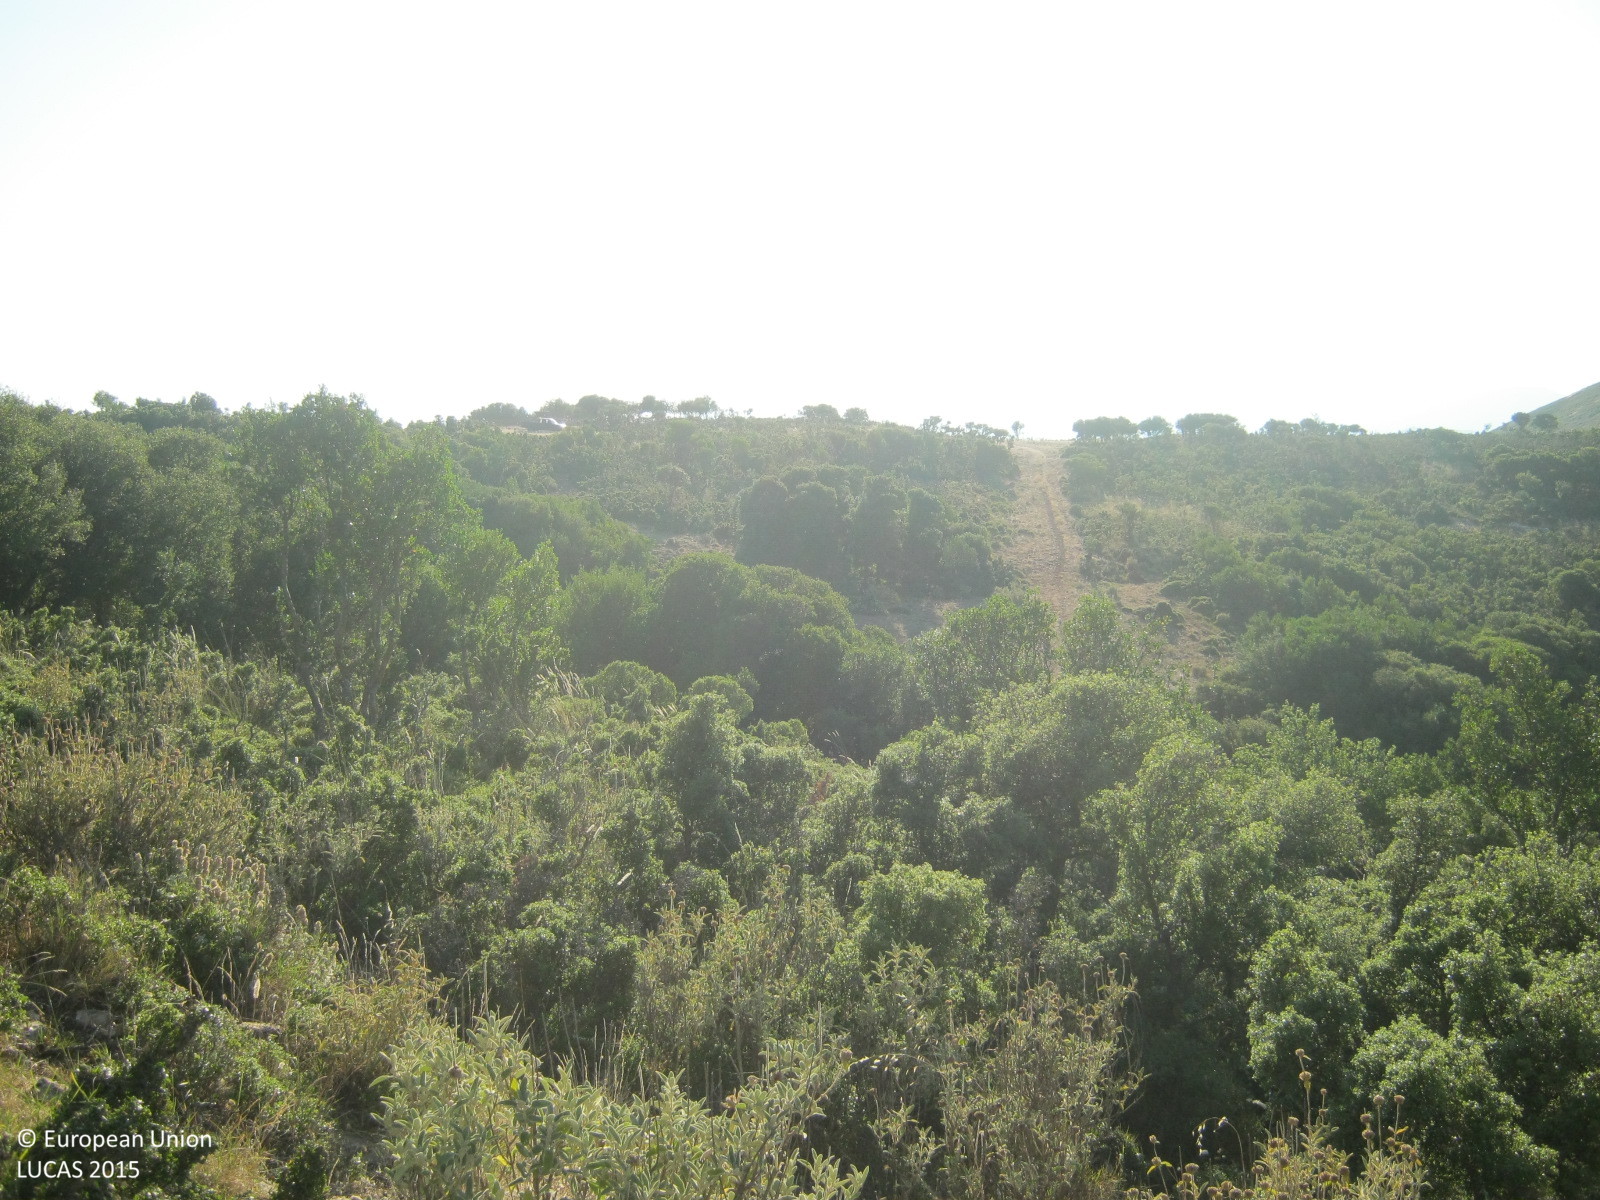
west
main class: Shrubland
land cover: Shrubland without tree cover
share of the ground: > 75 %
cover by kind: shrubs 85 %, unconsolidated bare surface 10 %, herbaceous plants 5 %
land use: Agriculture (excluding fallow land and kitchen gardens)
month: July
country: GR
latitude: 37.7758
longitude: 22.8096
